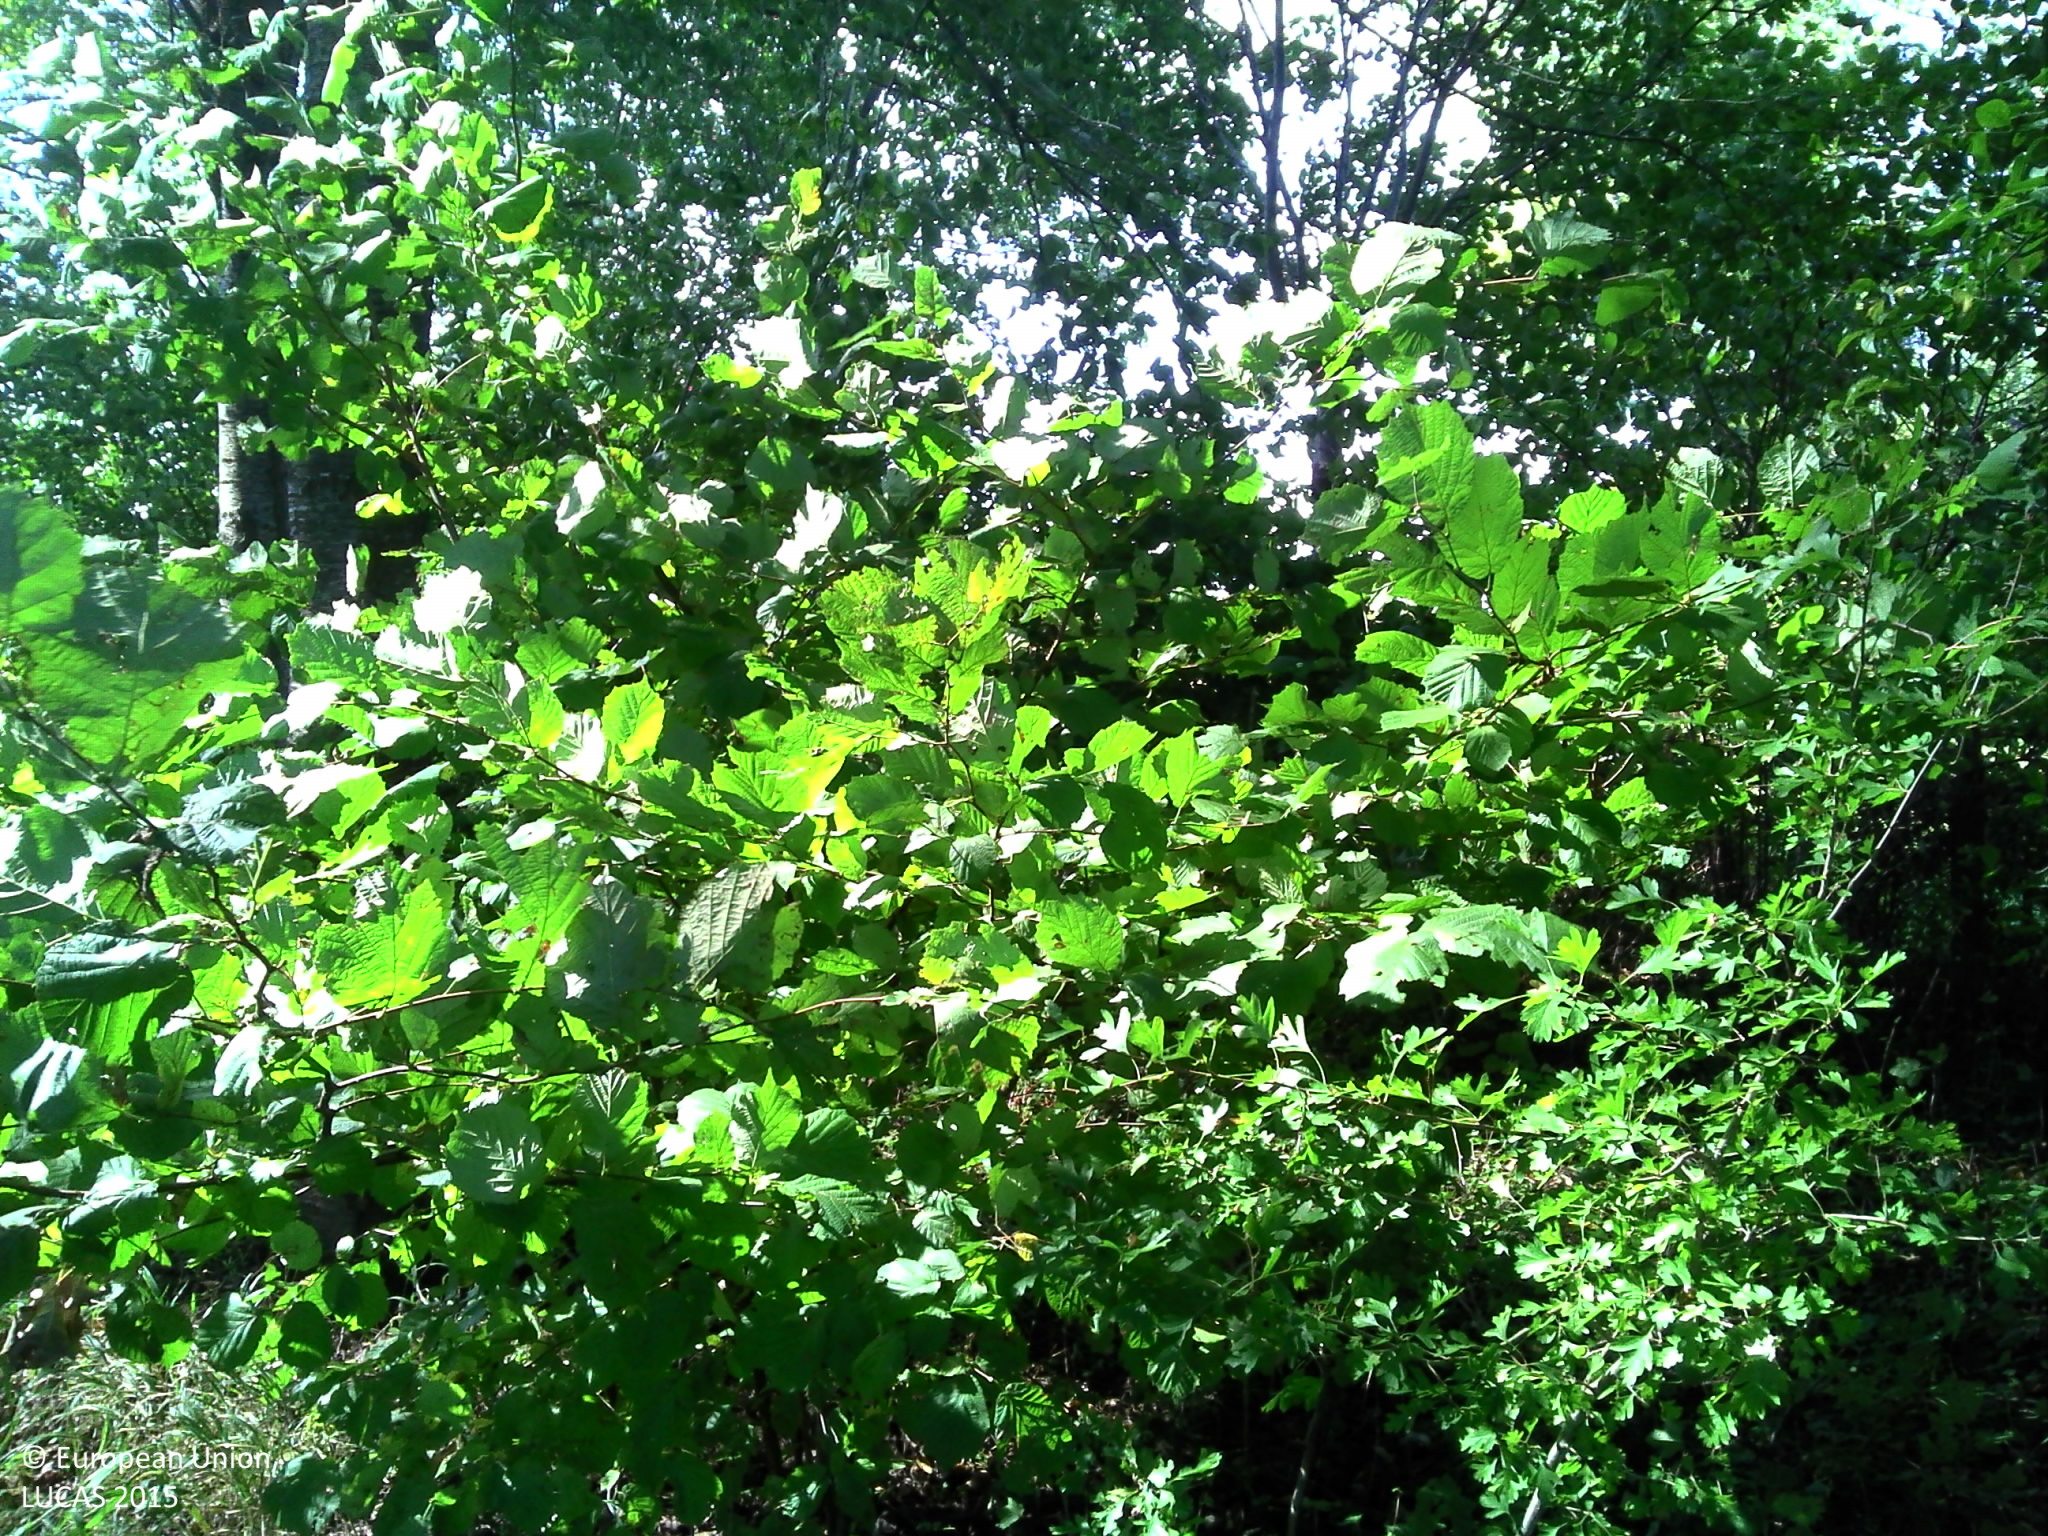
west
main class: Woodland
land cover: Broadleaved woodland
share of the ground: > 75 %
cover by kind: broadleaved forest trees 100 %
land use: Semi-natural and natural areas not in use
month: September
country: FR
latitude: 48.4162
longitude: 4.6066
